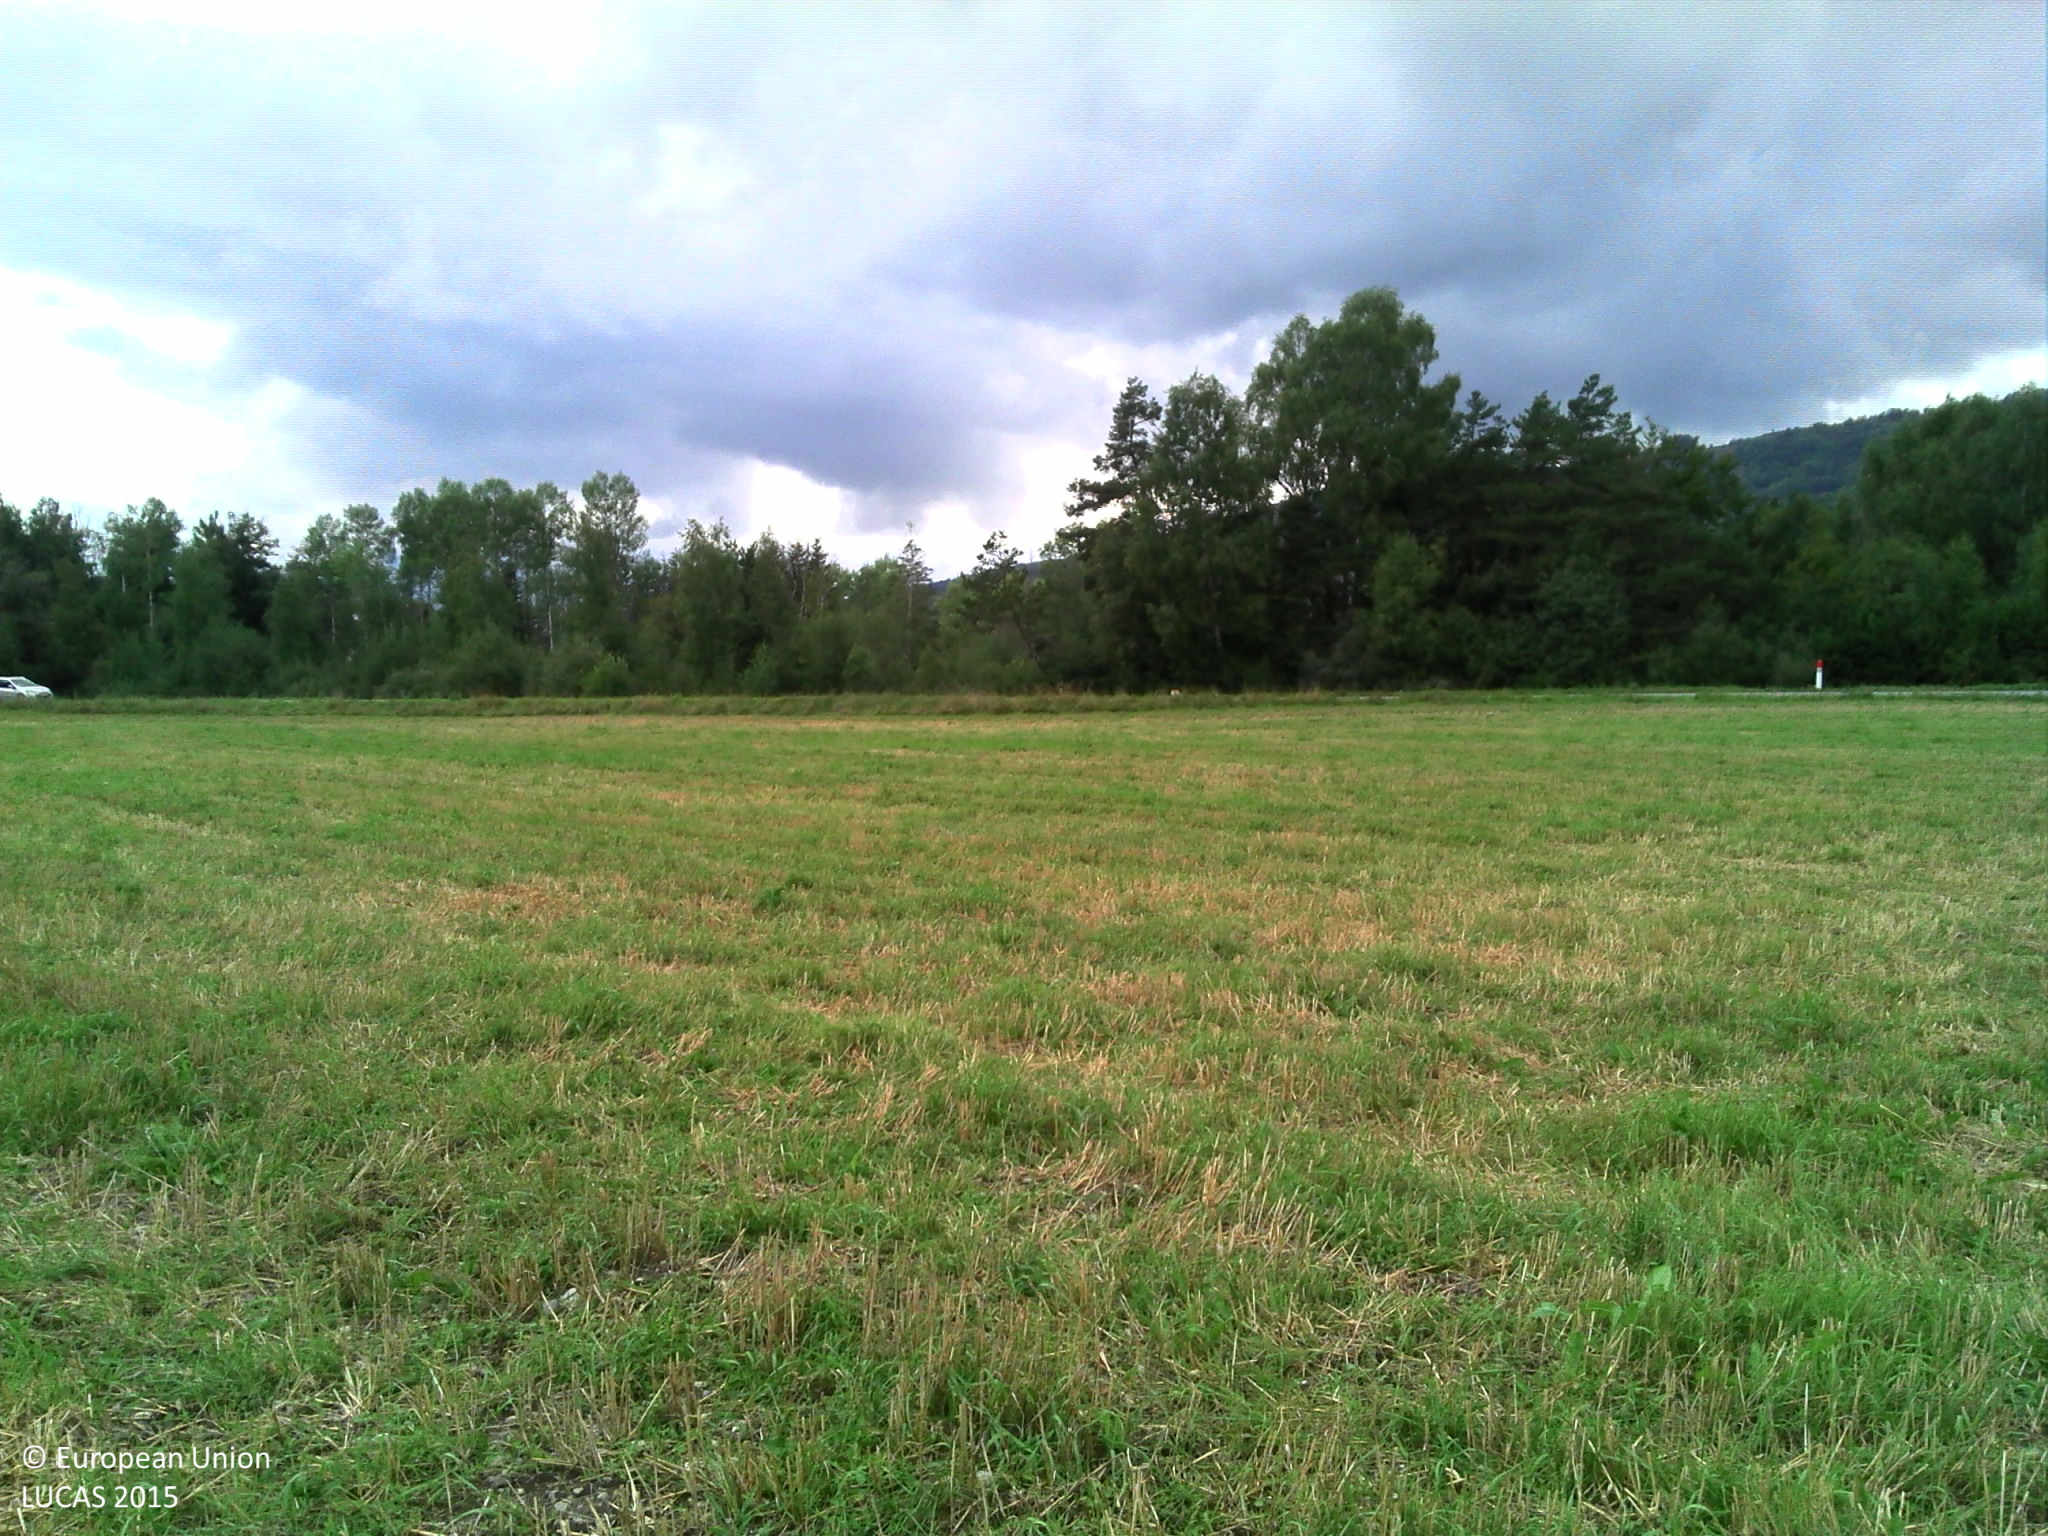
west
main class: Cropland
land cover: Common wheat
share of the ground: > 75 %
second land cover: Spontaneously vegetated surfaces
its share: > 75 %
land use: Agriculture (excluding fallow land and kitchen gardens)
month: September
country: FR
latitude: 44.6605
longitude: 6.2102
